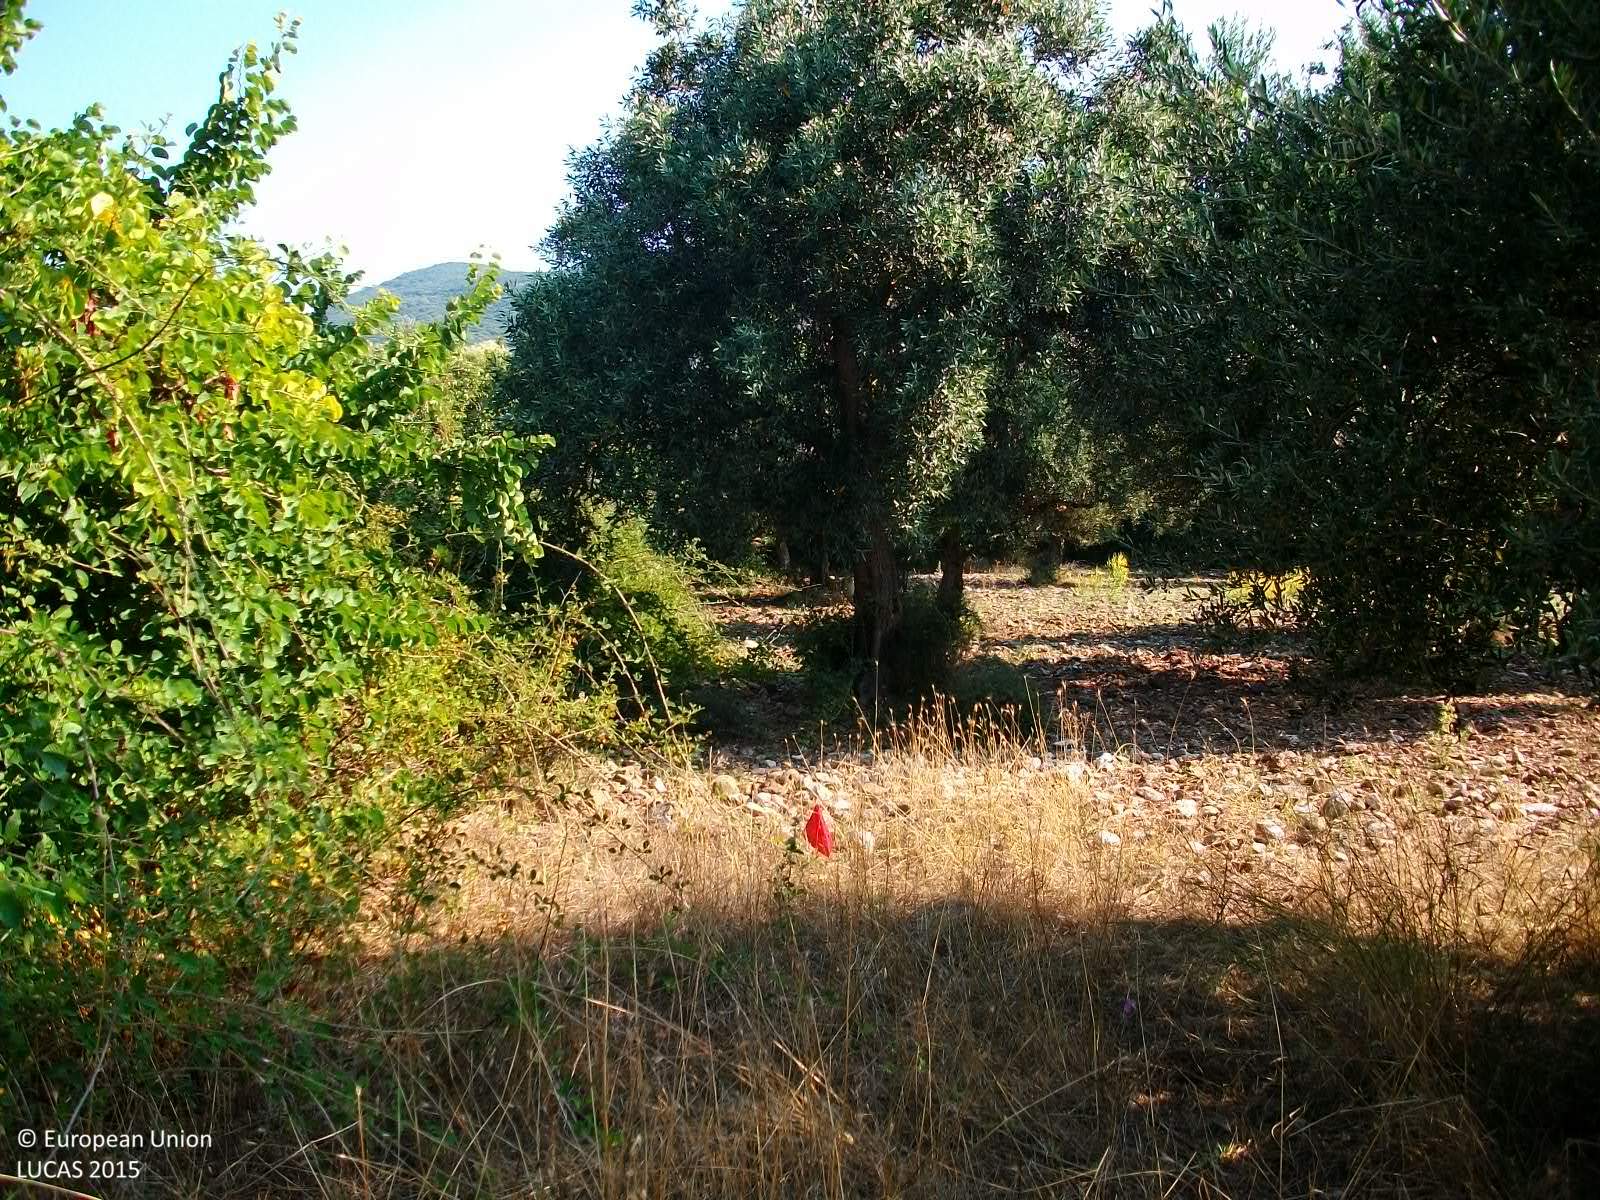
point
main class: Cropland
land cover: Olive groves
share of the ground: 50 - 75 %
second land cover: Spontaneously vegetated surfaces
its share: > 75 %
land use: Agriculture (excluding fallow land and kitchen gardens)
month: July
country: GR
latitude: 37.3233
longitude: 21.9299
